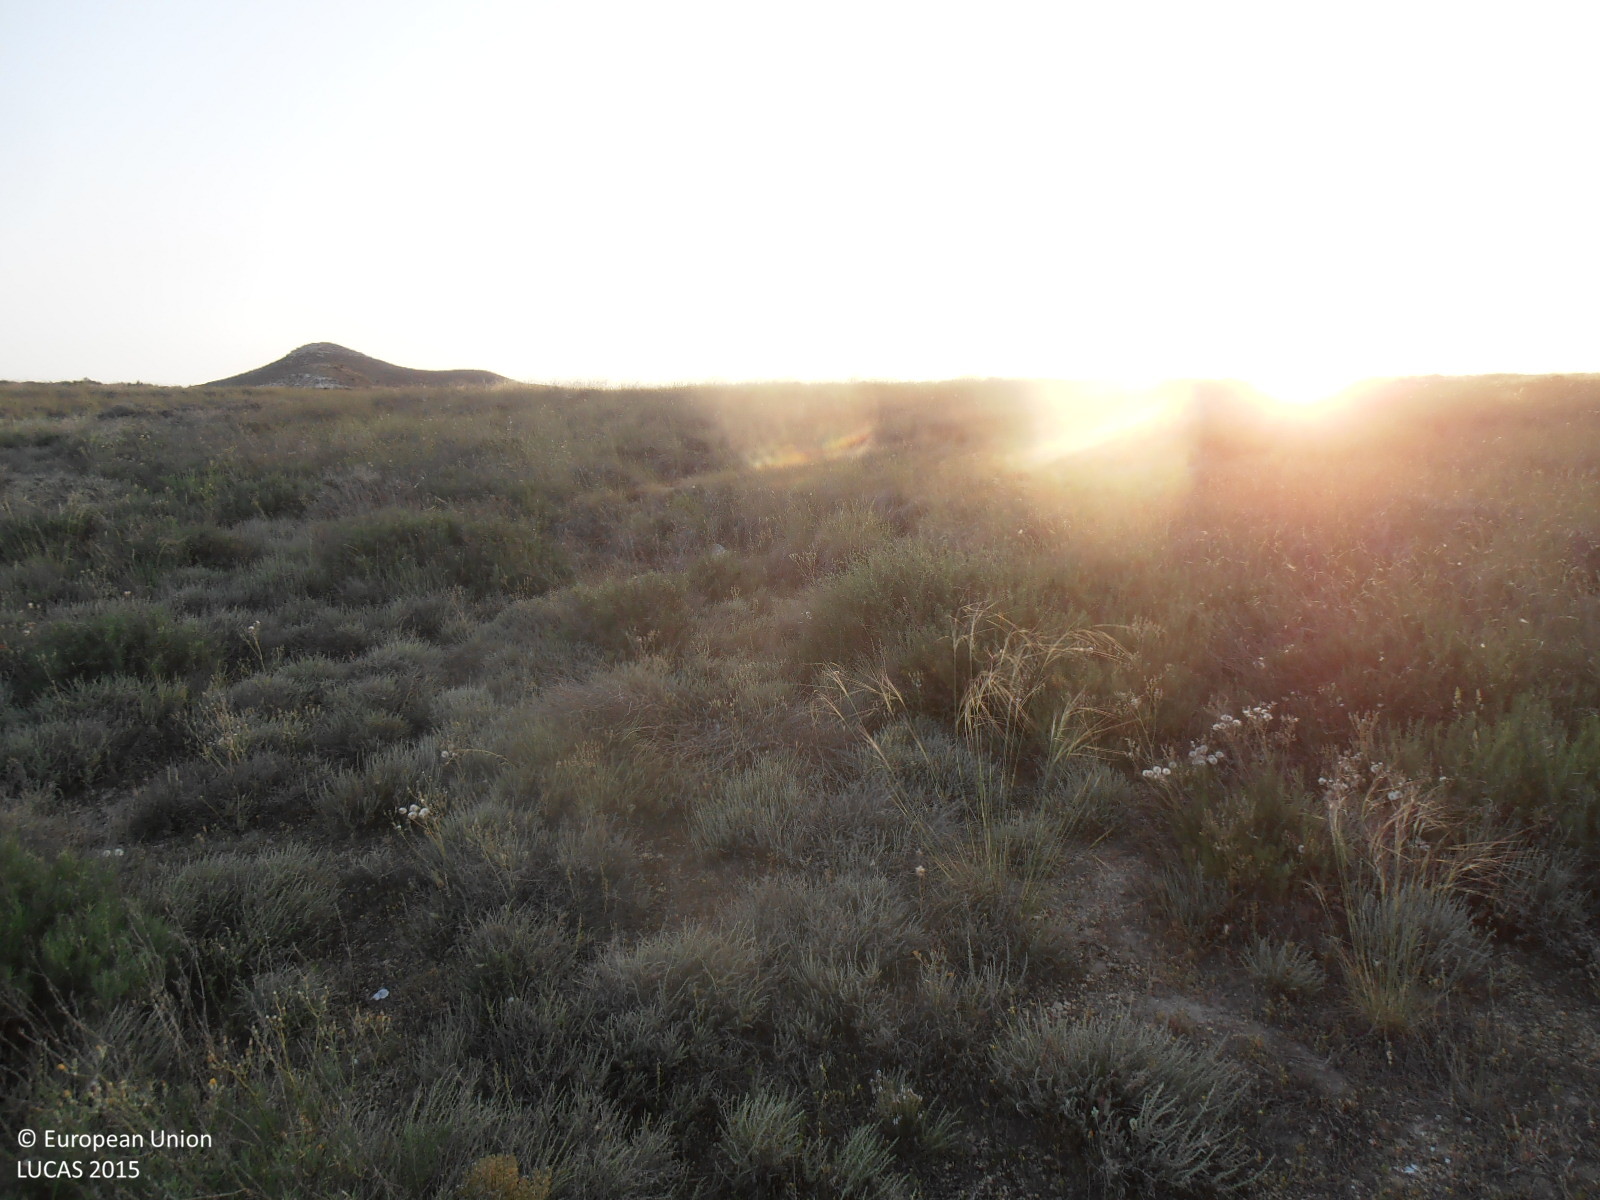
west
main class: Shrubland
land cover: Shrubland without tree cover
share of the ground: > 75 %
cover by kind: shrubs 90 %, herbaceous plants 10 %
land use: Semi-natural and natural areas not in use
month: May
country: ES
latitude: 41.5567
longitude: -1.0409
